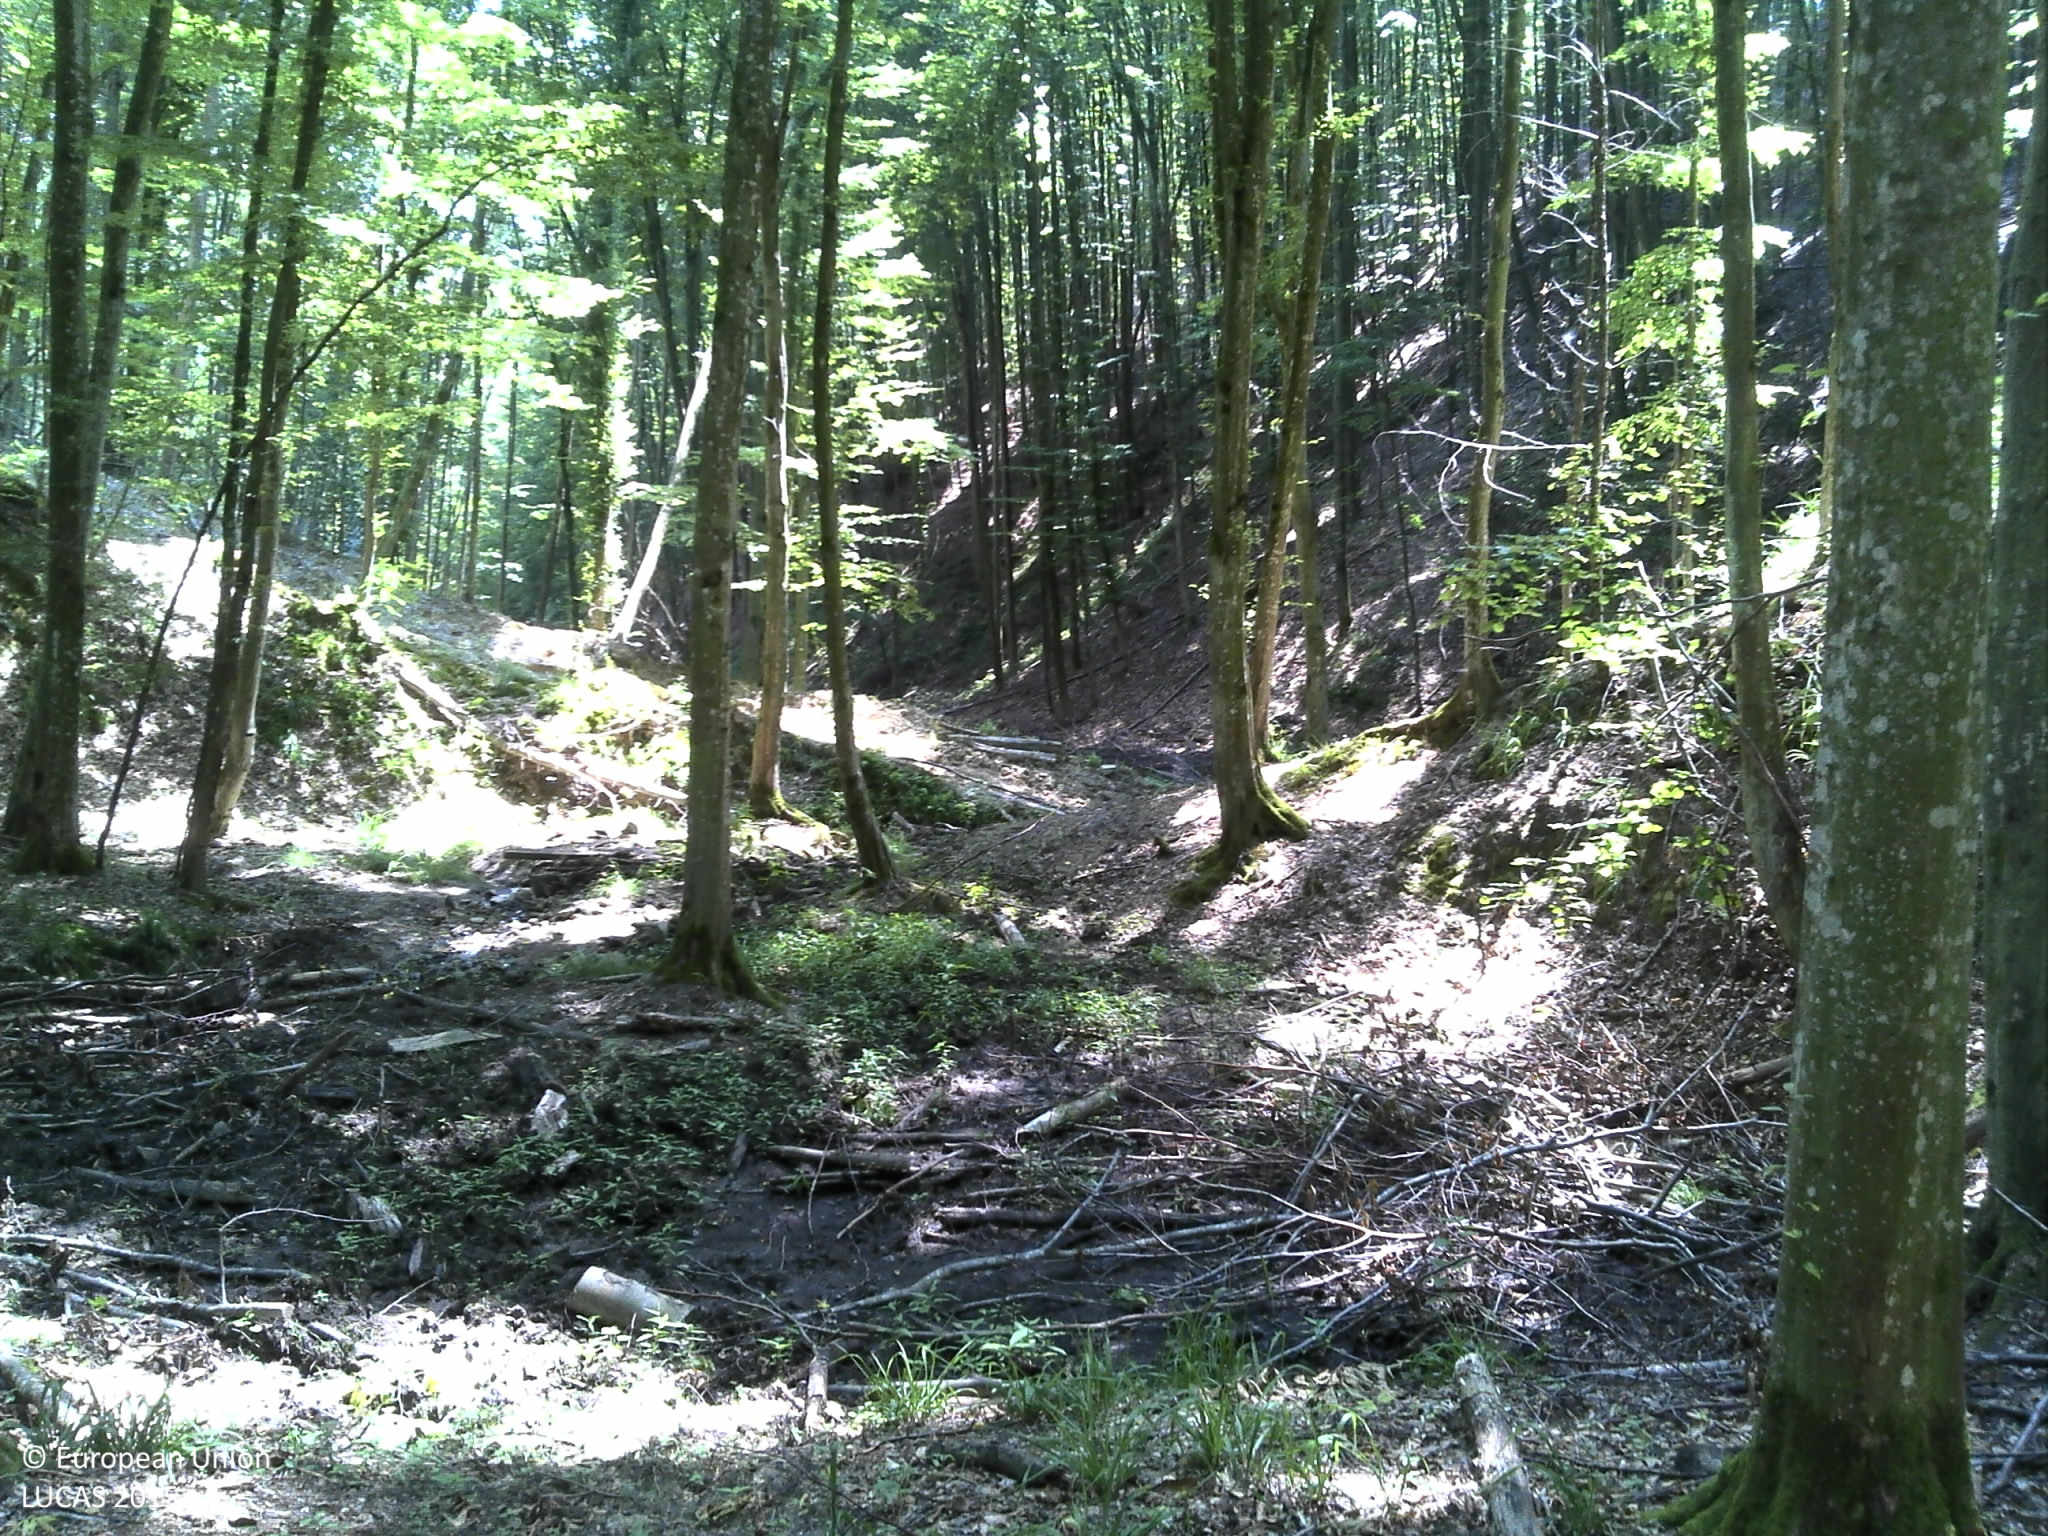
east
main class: Woodland
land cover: Broadleaved woodland
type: acidophilous oak and oak-birch forest
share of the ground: > 75 %
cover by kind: broadleaved forest trees 90 %, shrubs 5 %, herbaceous plants 5 %
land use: Forestry
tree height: > 5 m
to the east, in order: Broadleaved woodland; Ditches and canals; Broadleaved woodland; Tracks; Broadleaved woodland; Tracks; Broadleaved woodland; Ditches and canals; Broadleaved woodland
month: July
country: HR
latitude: 45.6915
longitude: 16.6639
